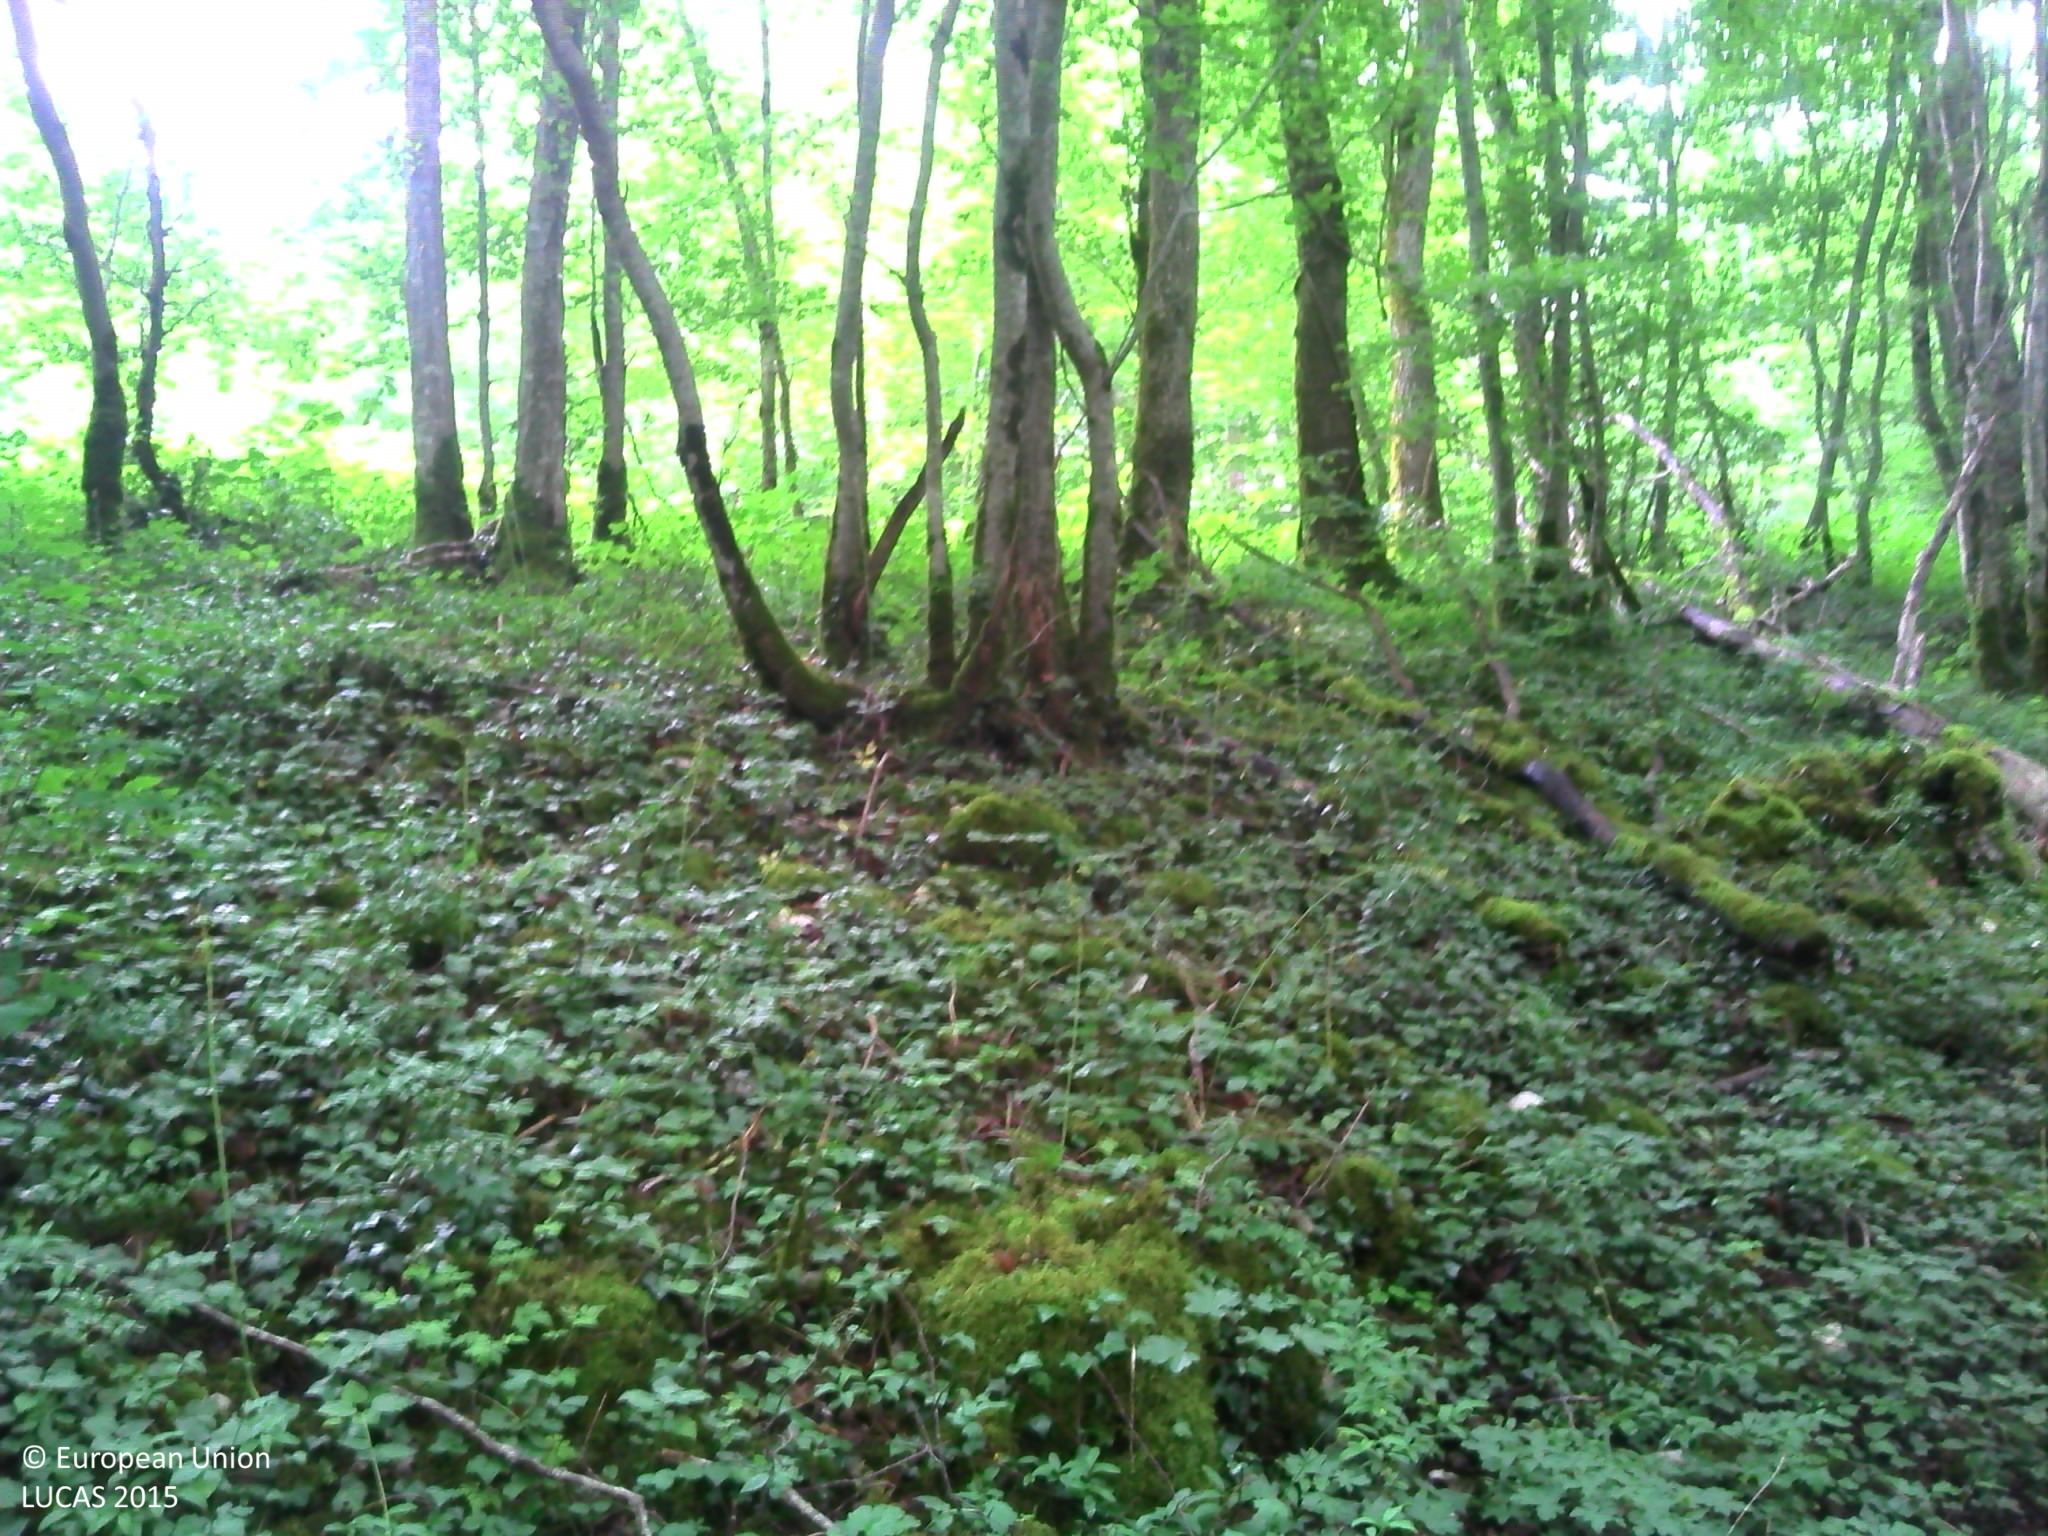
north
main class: Woodland
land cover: Broadleaved woodland
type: mesophytic deciduous forest
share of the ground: > 75 %
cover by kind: broadleaved forest trees 80 %, coniferous forest trees 10 %, herbaceous plants 5 %, lichens and mosses 5 %
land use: Forestry
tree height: > 5 m
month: June
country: FR
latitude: 48.1922
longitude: 5.2236
